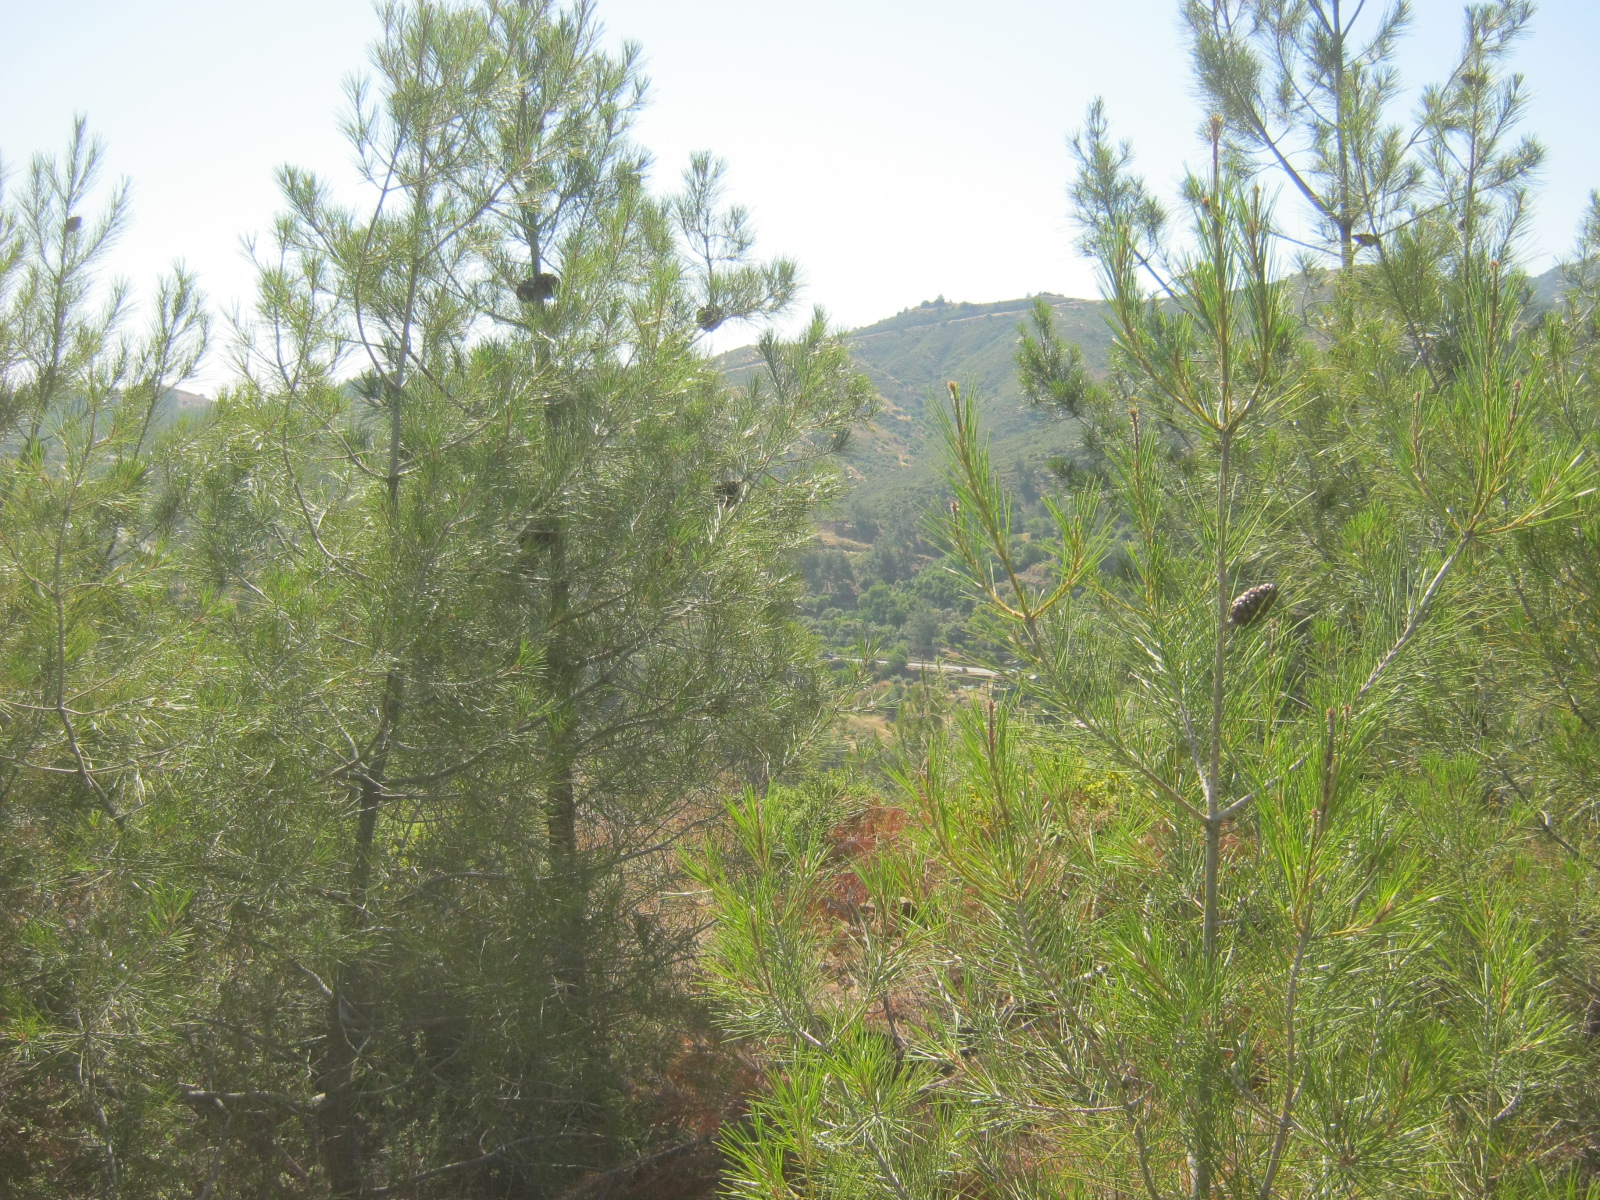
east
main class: Woodland
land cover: Pine dominated coniferous woodland
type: coniferous forest of the mediterranean region
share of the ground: 25 - 50 %
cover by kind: coniferous forest trees 40 %, shrubs 25 %, herbaceous plants 20 %, unconsolidated bare surface 15 %
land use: Forestry
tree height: < 5 m
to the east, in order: Pine dominated coniferous woodland; Shrubland with sparse tree cover; Rocks and stones; Paved roads, cycling and walking lanes; Rocks and stones; Pine dominated coniferous woodland
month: May
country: CY
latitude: 35.0612
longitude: 32.8340
